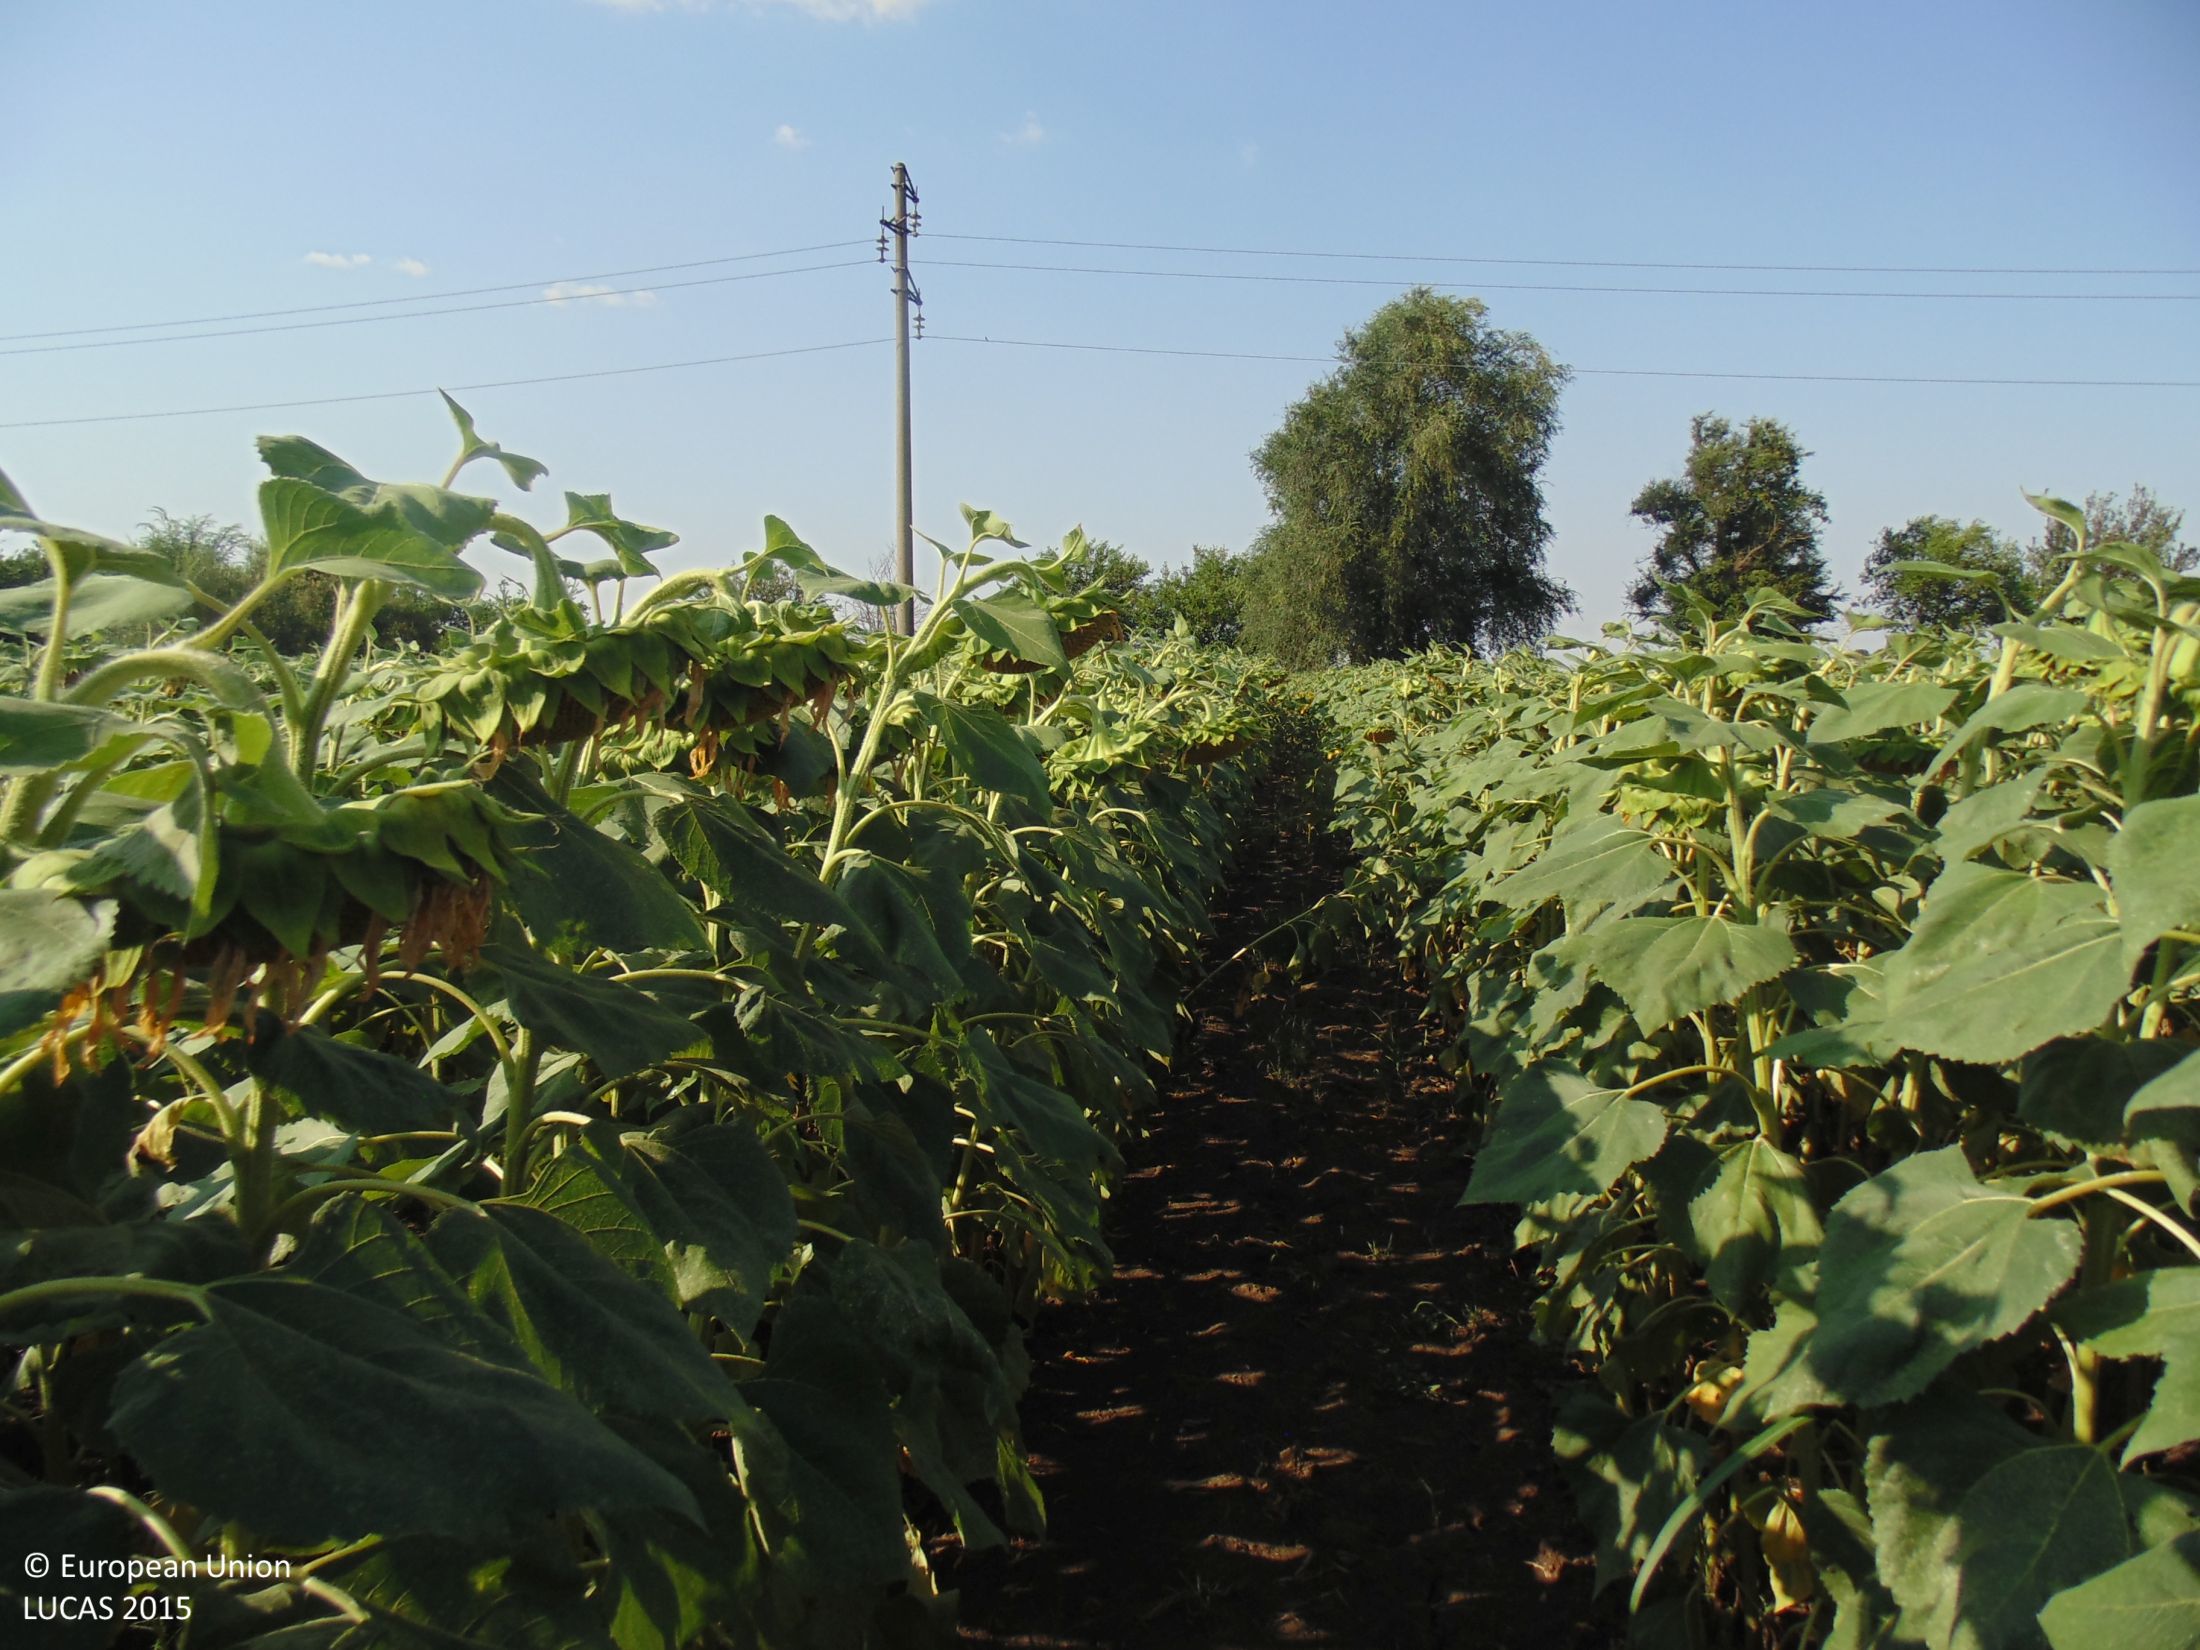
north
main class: Cropland
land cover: Sunflower
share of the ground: > 75 %
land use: Agriculture (excluding fallow land and kitchen gardens)
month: July
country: BG
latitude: 43.6505
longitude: 27.5541
